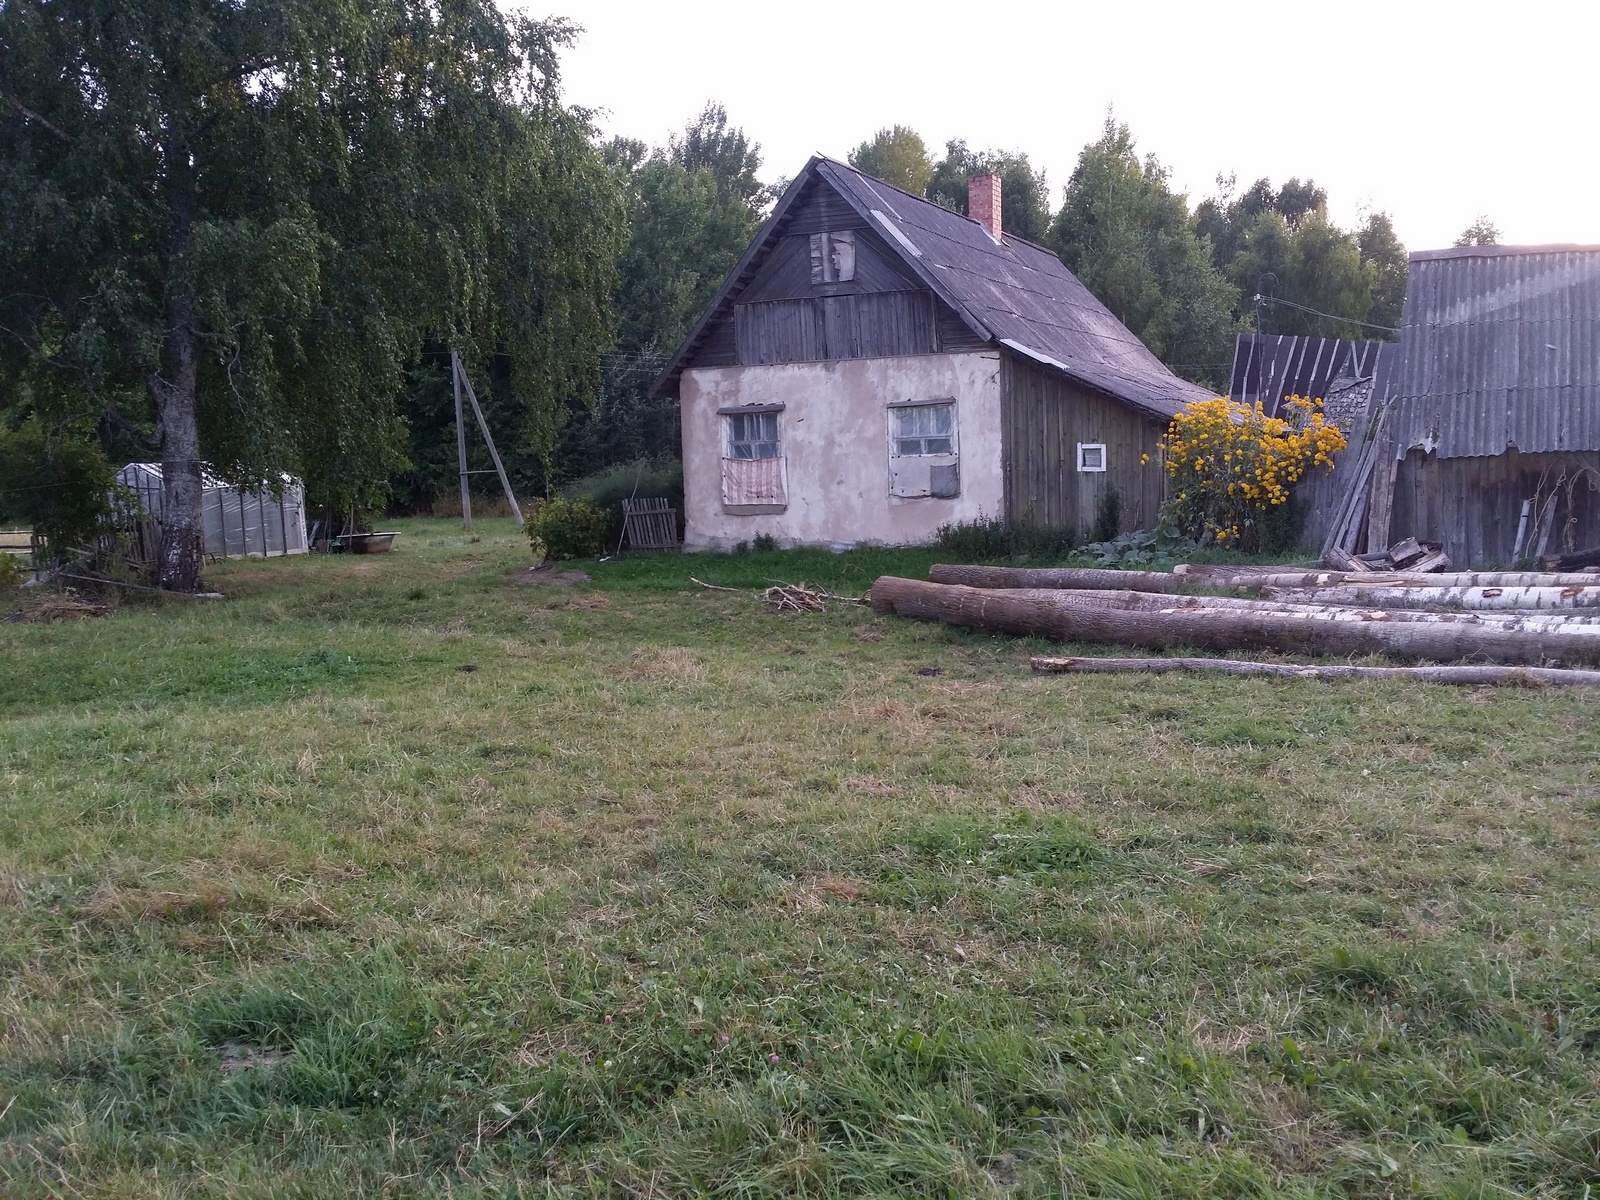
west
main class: Grassland
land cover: Grassland without tree/shrub cover
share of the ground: > 75 %
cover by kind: herbaceous plants 90 %, unconsolidated bare surface 10 %
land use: Agriculture (excluding fallow land and kitchen gardens)
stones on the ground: < 10 %
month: August
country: LV
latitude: 57.1946
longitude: 27.7083
